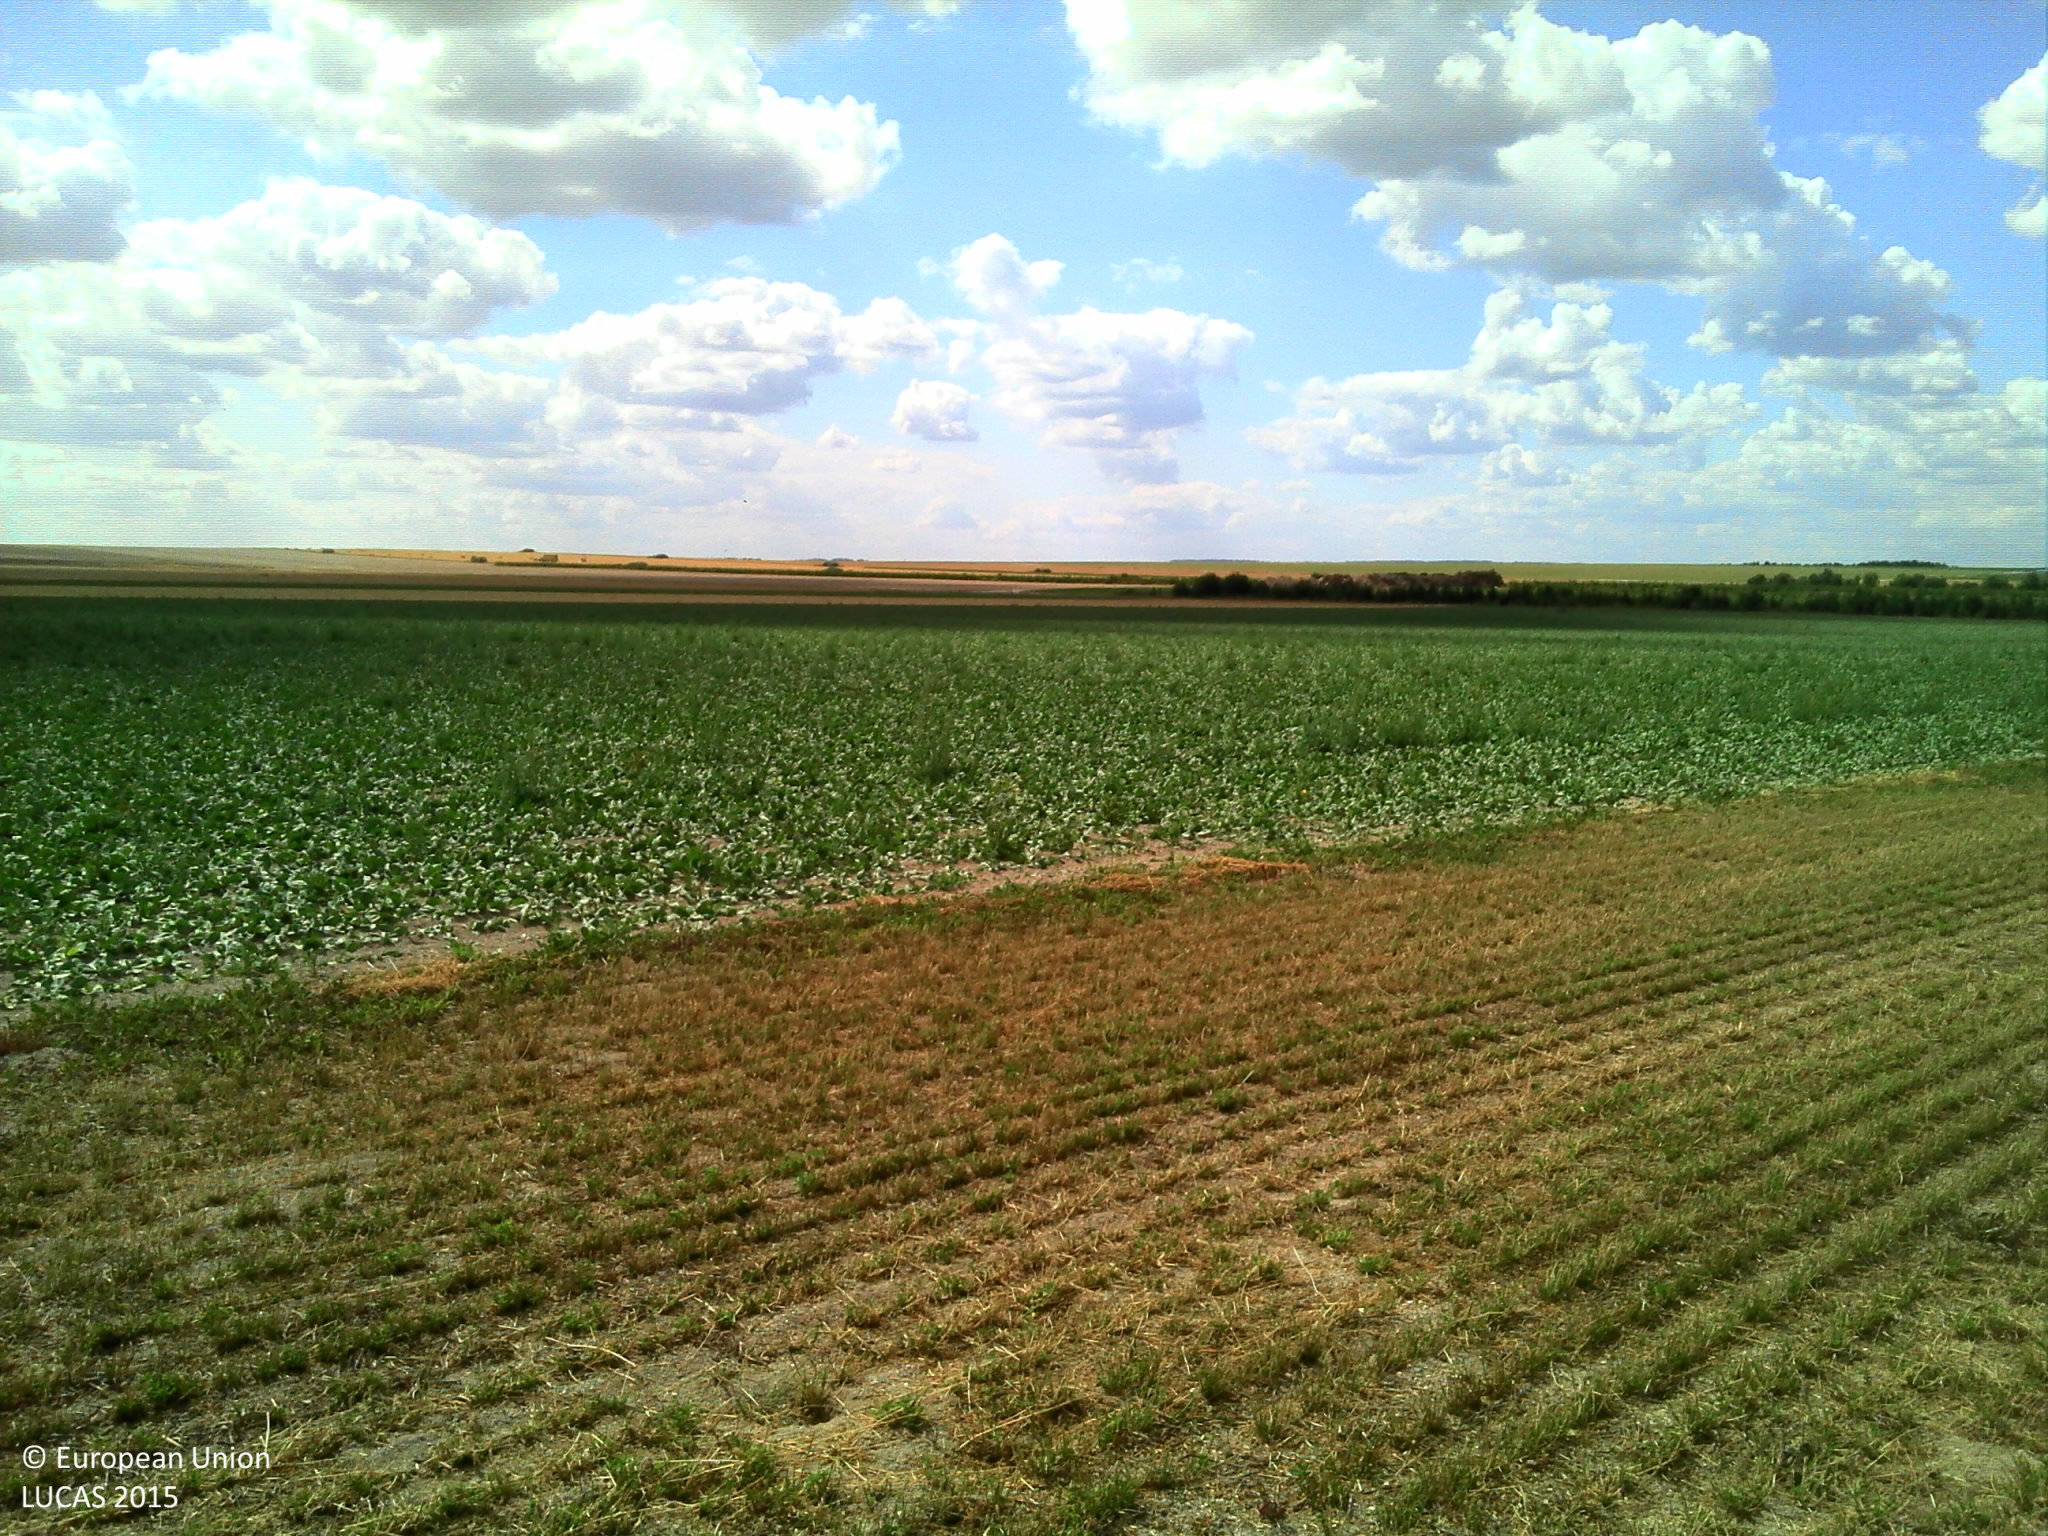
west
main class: Cropland
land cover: Lucerne
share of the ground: > 75 %
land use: Agriculture (excluding fallow land and kitchen gardens)
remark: Harvested field
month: July
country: FR
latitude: 48.8991
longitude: 4.1710
